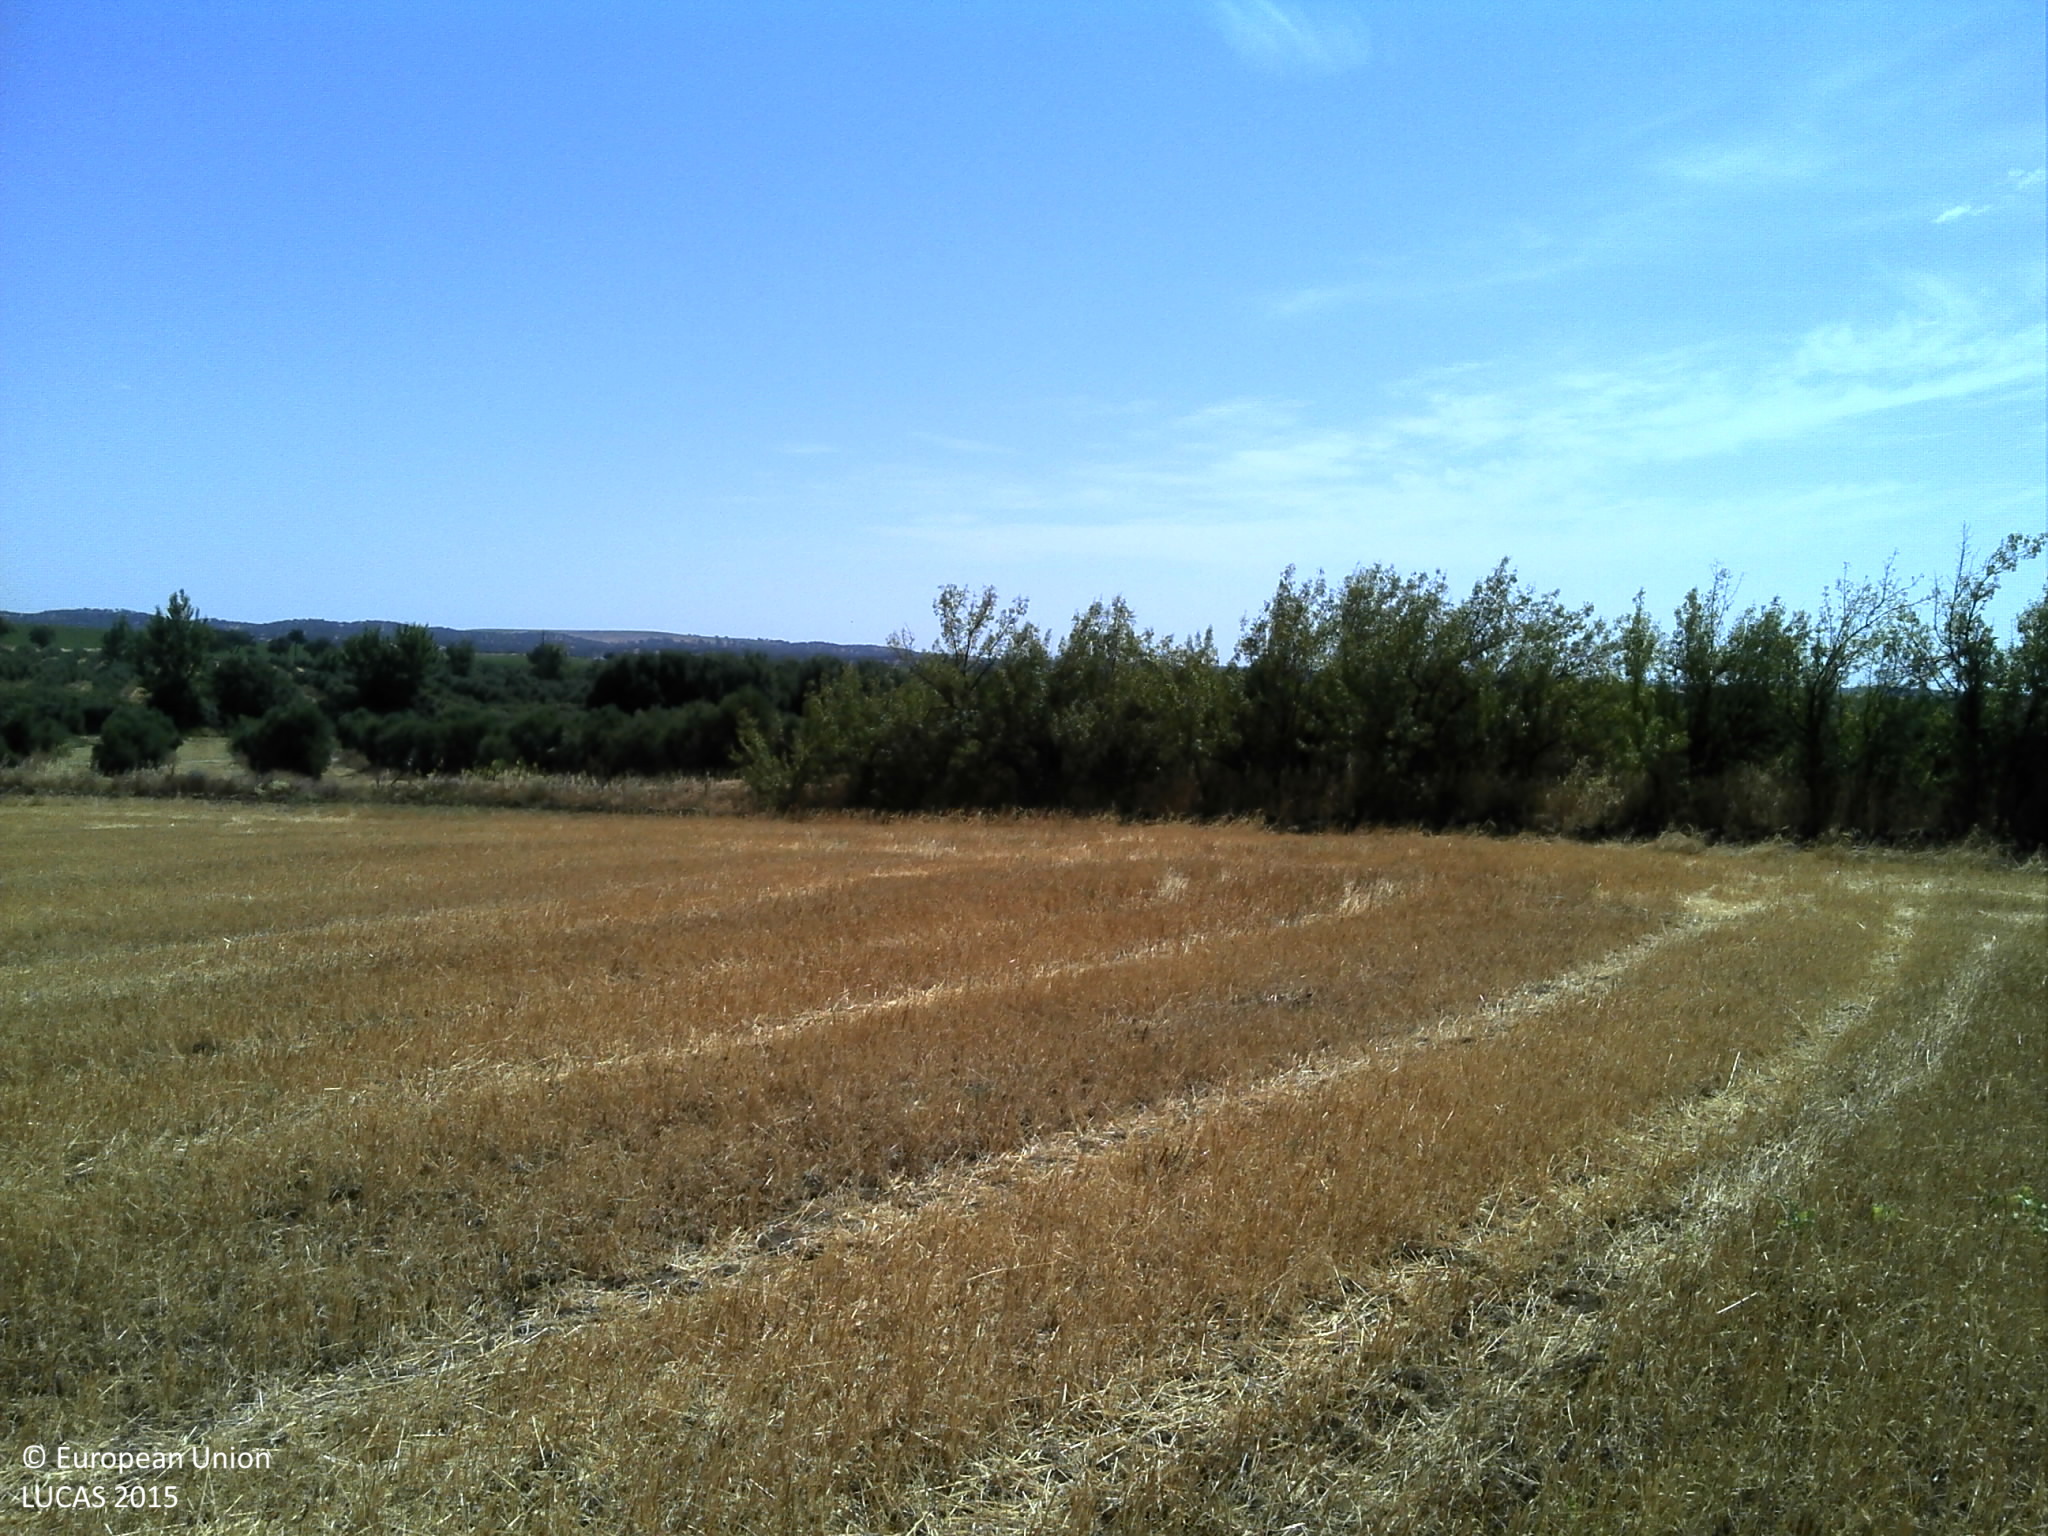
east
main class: Cropland
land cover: Oats
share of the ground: < 10 %
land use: Agriculture (excluding fallow land and kitchen gardens)
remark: Harvested field
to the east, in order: Oats; Shruby margins; Fences; Other bare soil; Olive groves; Rocks and stones; Olive groves; Single bushes/trees; Other bare soil; Rocks and stones; Broadleaved woodland; Other bare soil; Olive groves
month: July
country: PT
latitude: 38.4736
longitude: -7.7193
